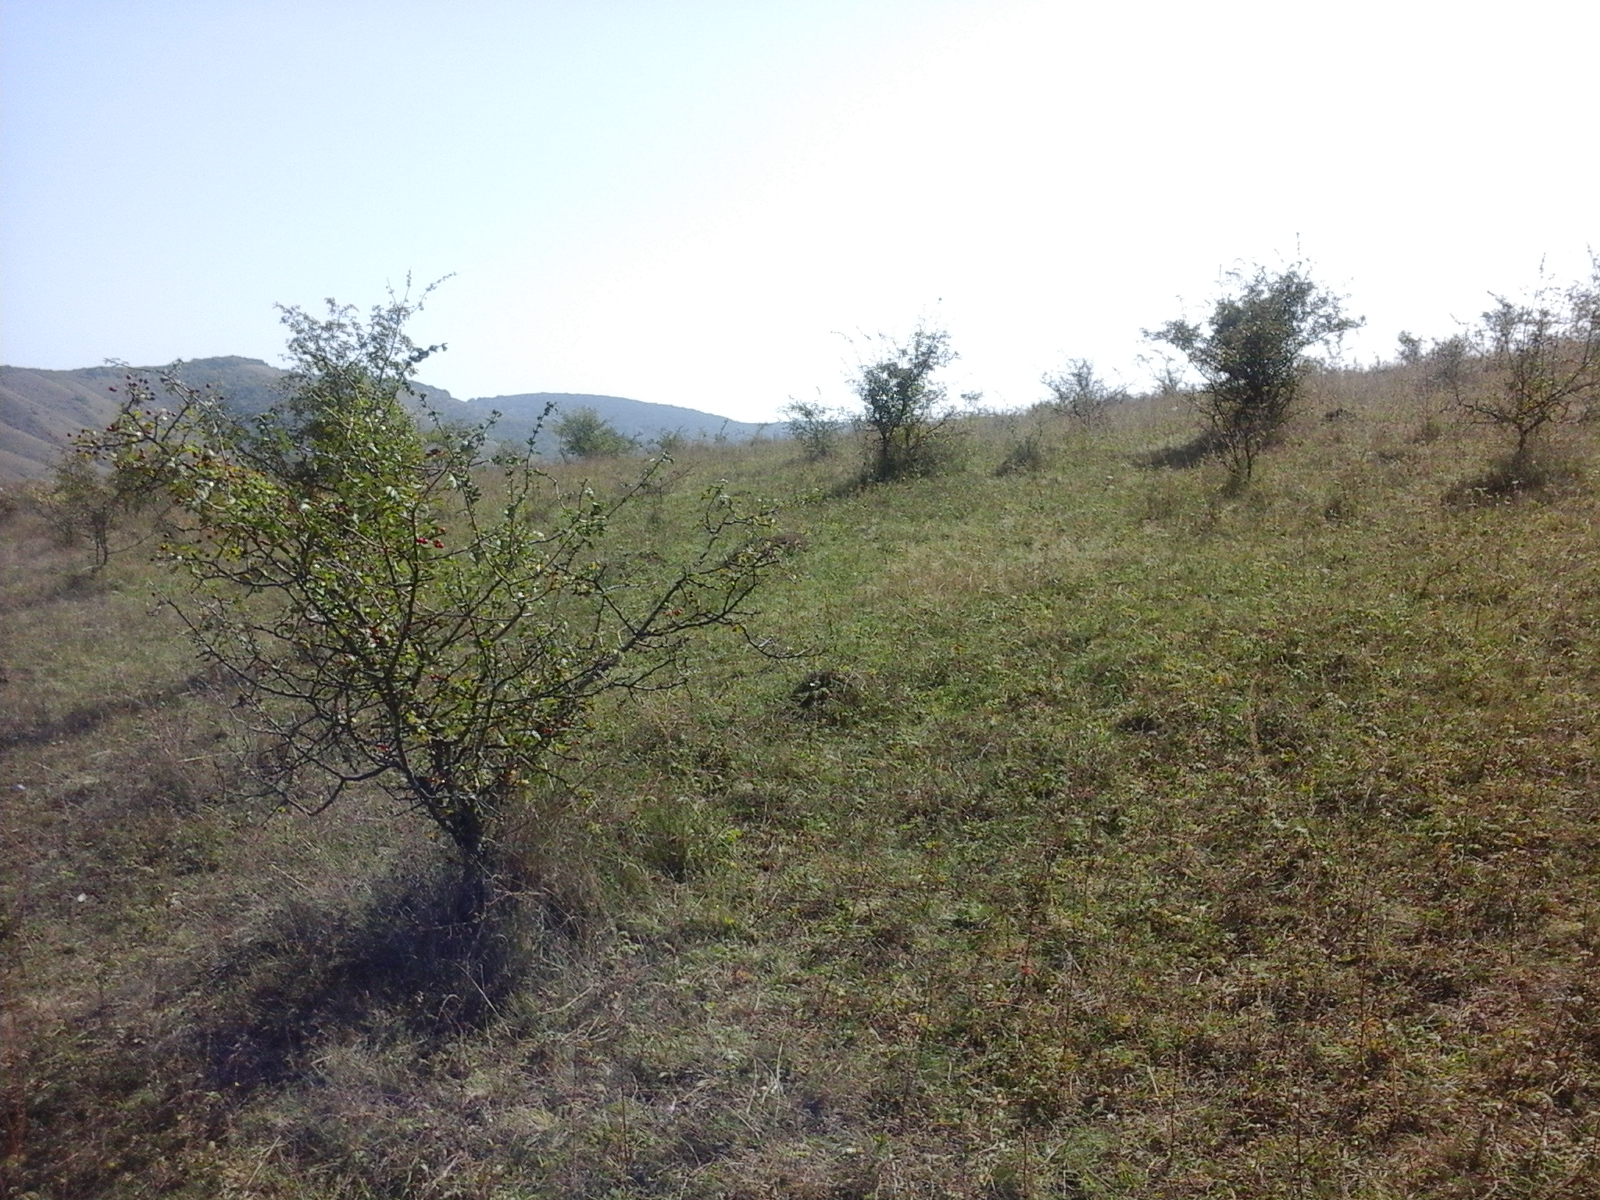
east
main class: Grassland
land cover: Grassland with sparse tree/shrub cover
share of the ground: > 75 %
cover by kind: herbaceous plants 85 %, shrubs 10 %, broadleaved forest trees 5 %
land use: Agriculture (excluding fallow land and kitchen gardens)
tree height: < 5 m
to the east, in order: Grassland with sparse tree/shrub cover; Grassland without tree/shrub cover; Lucerne
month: September
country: RO
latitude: 46.8994
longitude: 23.8998
